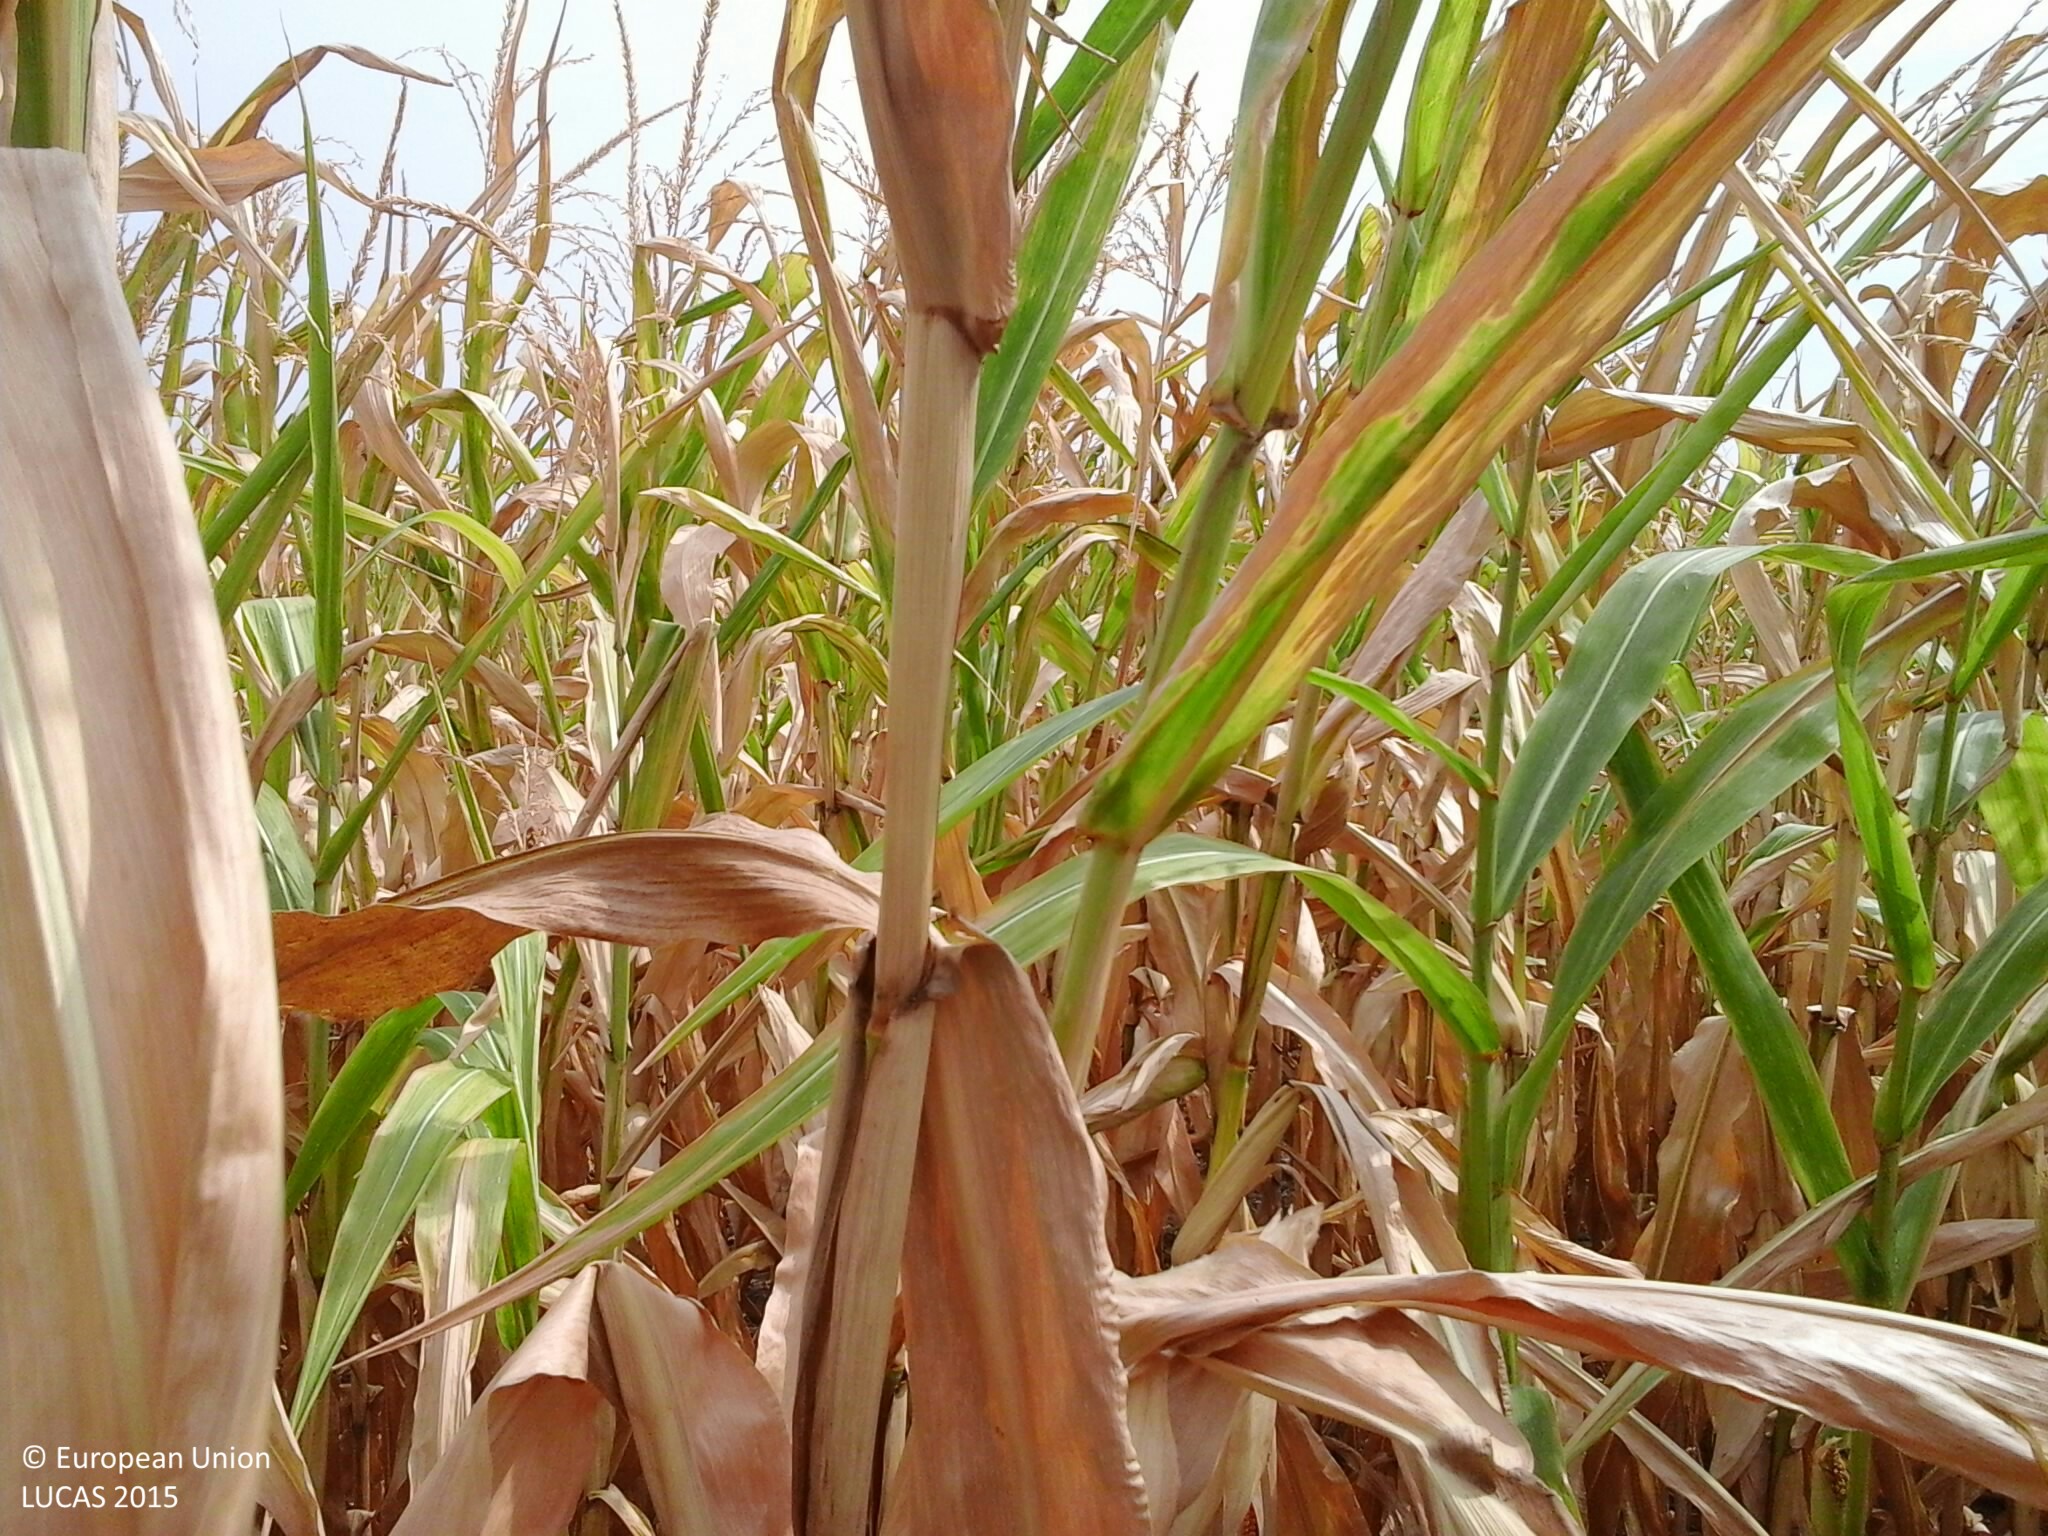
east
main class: Cropland
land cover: Maize
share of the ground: > 75 %
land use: Agriculture (excluding fallow land and kitchen gardens)
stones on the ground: < 10 %
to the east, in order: Maize; Grassland with sparse tree/shrub cover; Ditches and canals; Tracks; Grassland with sparse tree/shrub cover; Common wheat
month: August
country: HU
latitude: 47.7590
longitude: 20.2889
